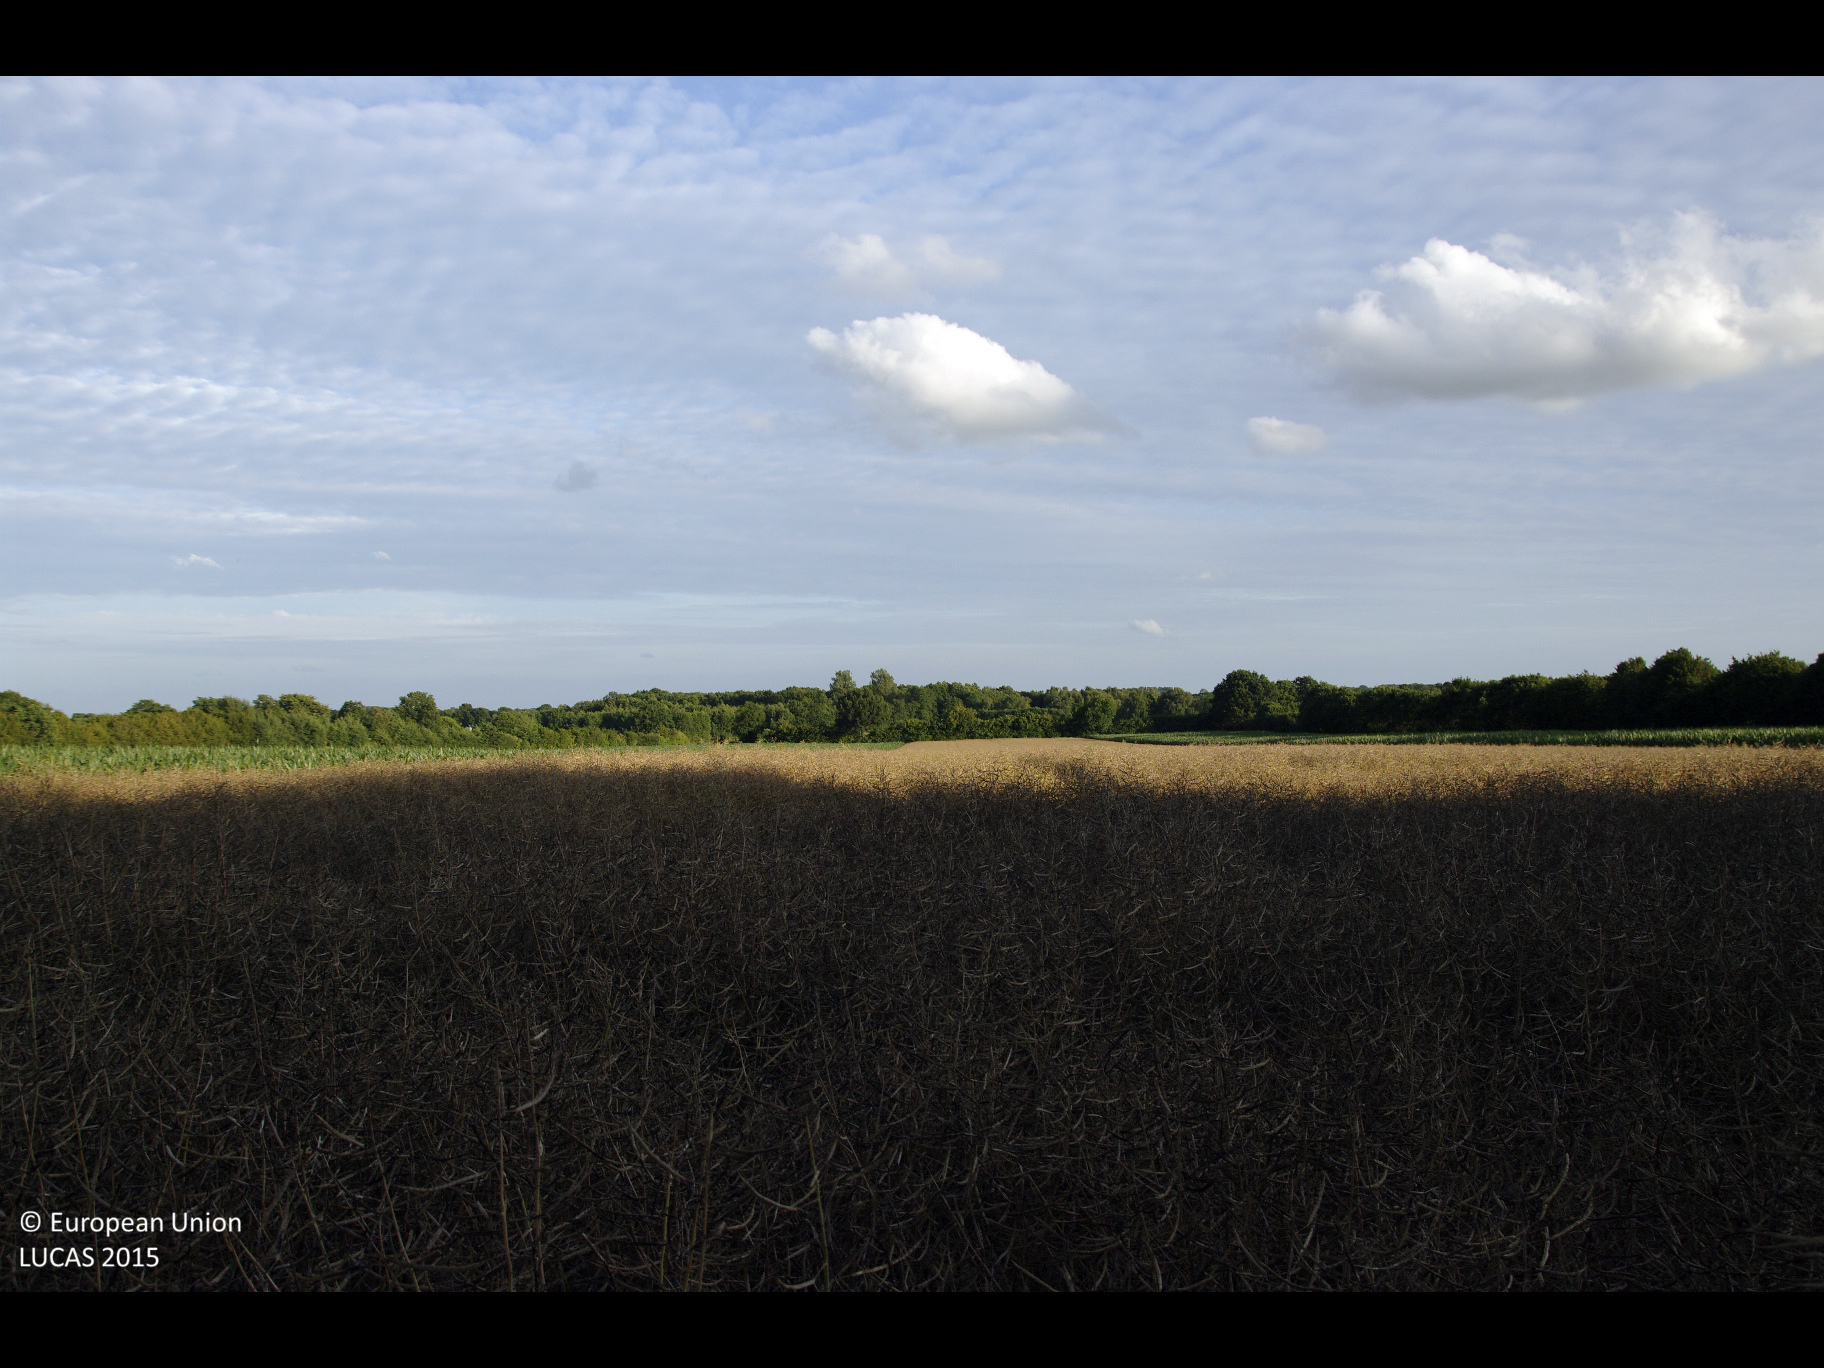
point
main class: Cropland
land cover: Rape and turnip rape
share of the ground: > 75 %
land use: Agriculture (excluding fallow land and kitchen gardens)
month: July
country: DE
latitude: 53.9769
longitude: 9.8324
